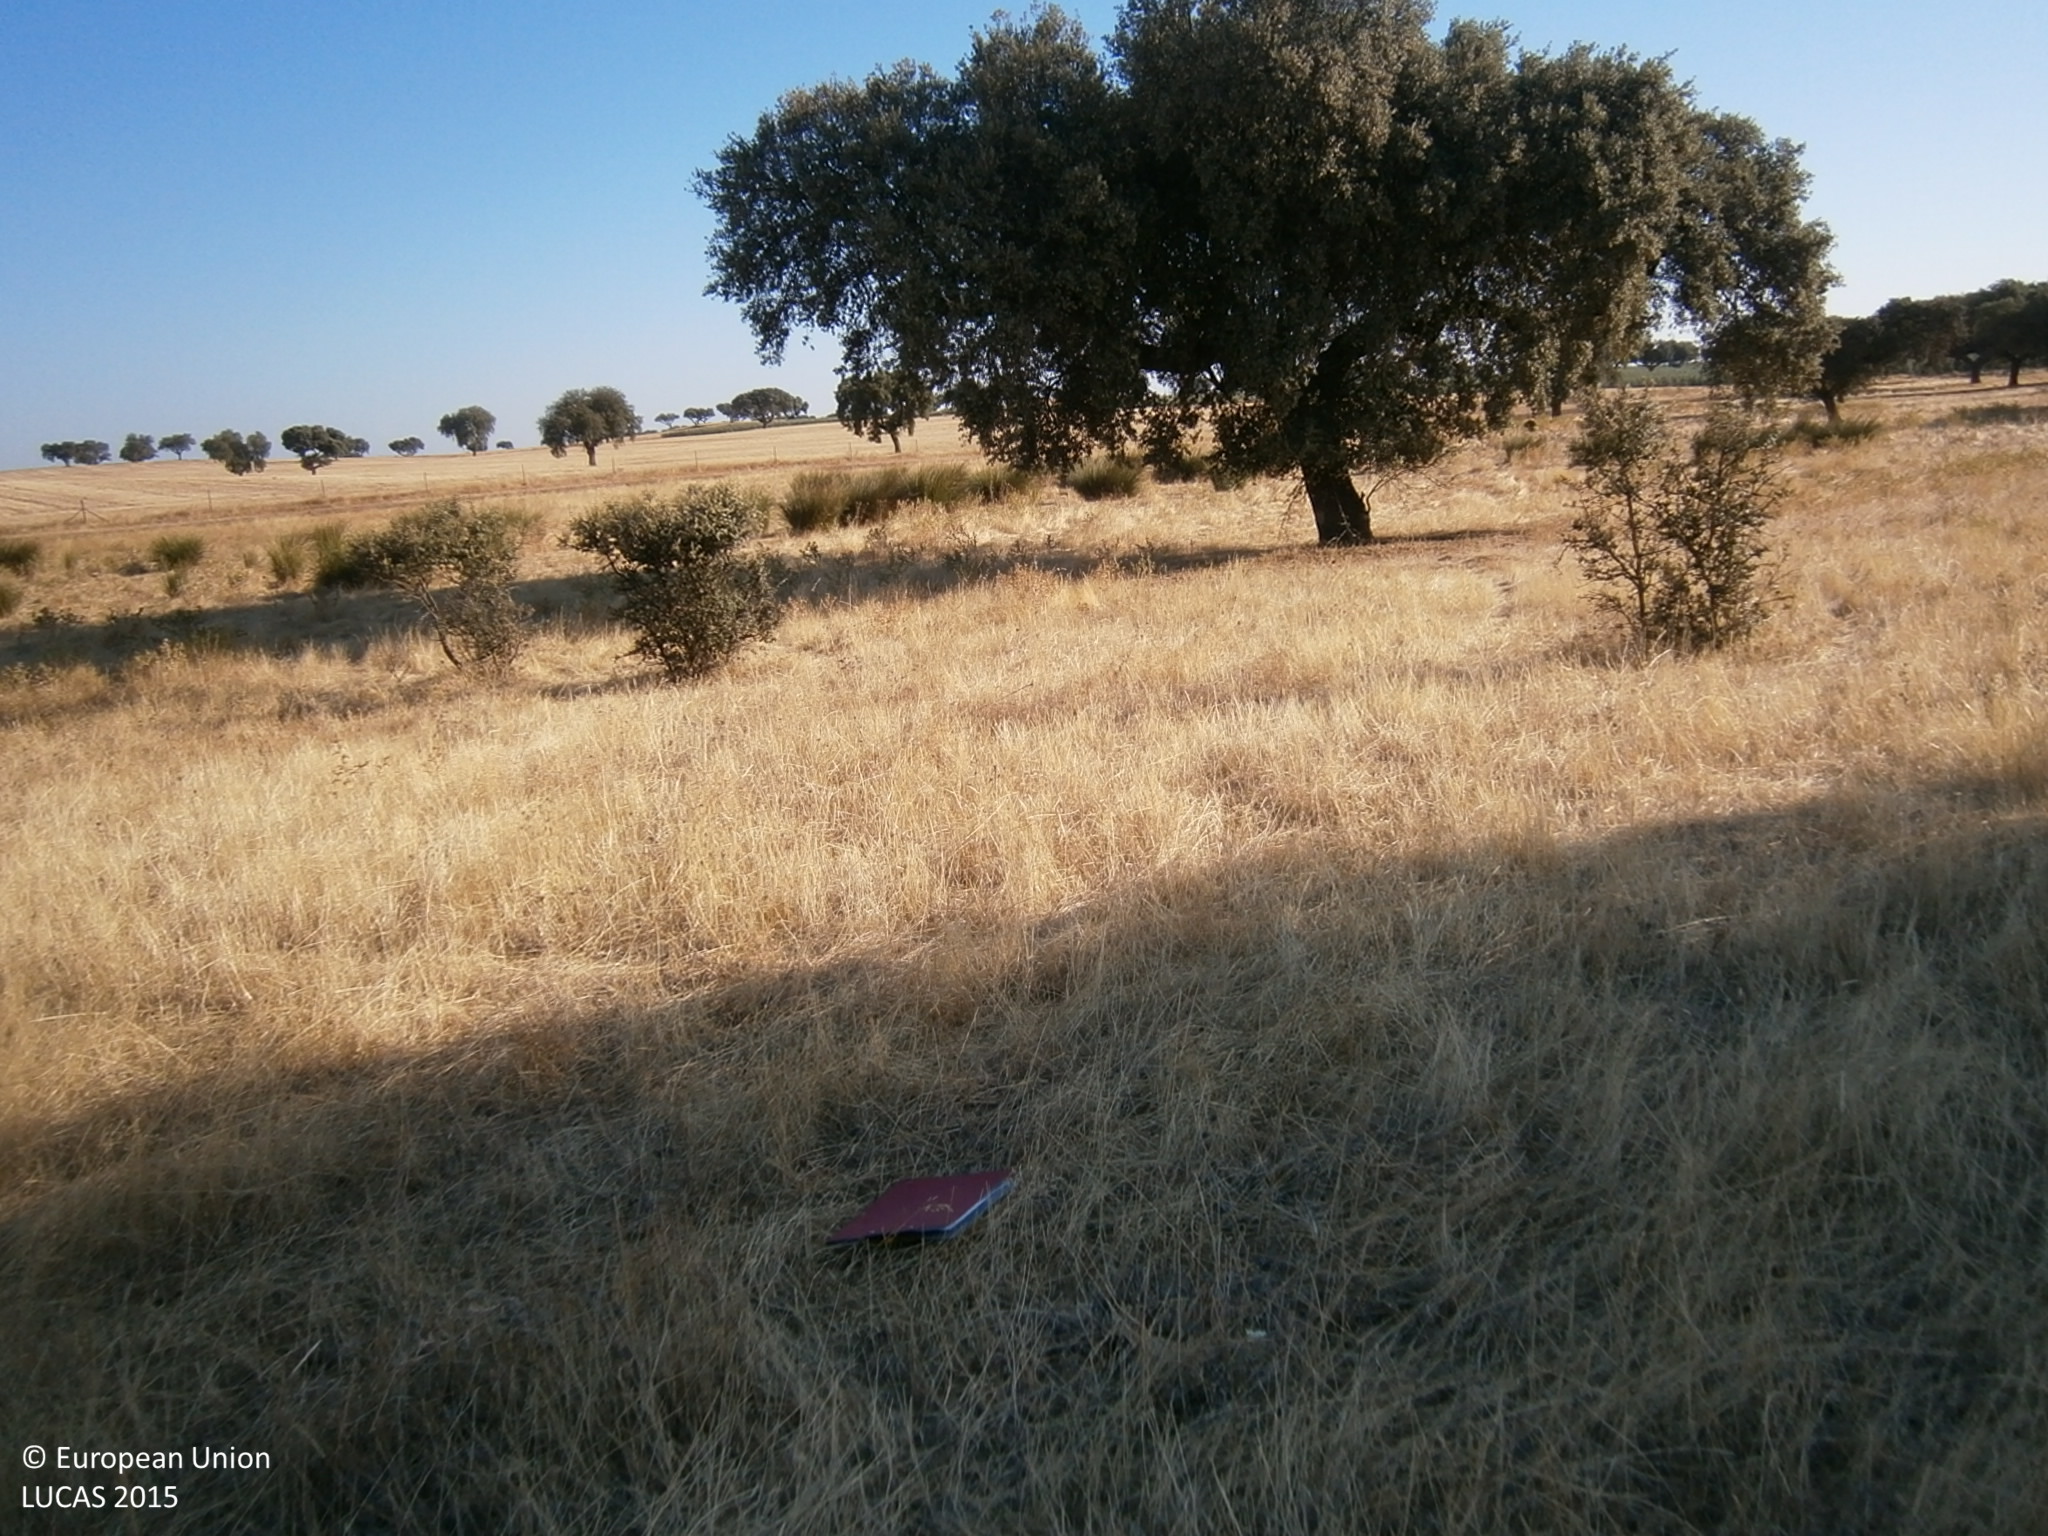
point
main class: Woodland
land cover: Broadleaved woodland
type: broadleaved evergreen forest
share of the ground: > 75 %
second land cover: Spontaneously vegetated surfaces
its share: > 75 %
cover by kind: broadleaved forest trees 90 %, shrubs 5 %
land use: Forestry
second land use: Agriculture (excluding fallow land and kitchen gardens)
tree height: > 5 m
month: July
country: ES
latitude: 38.9684
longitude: -6.7207
